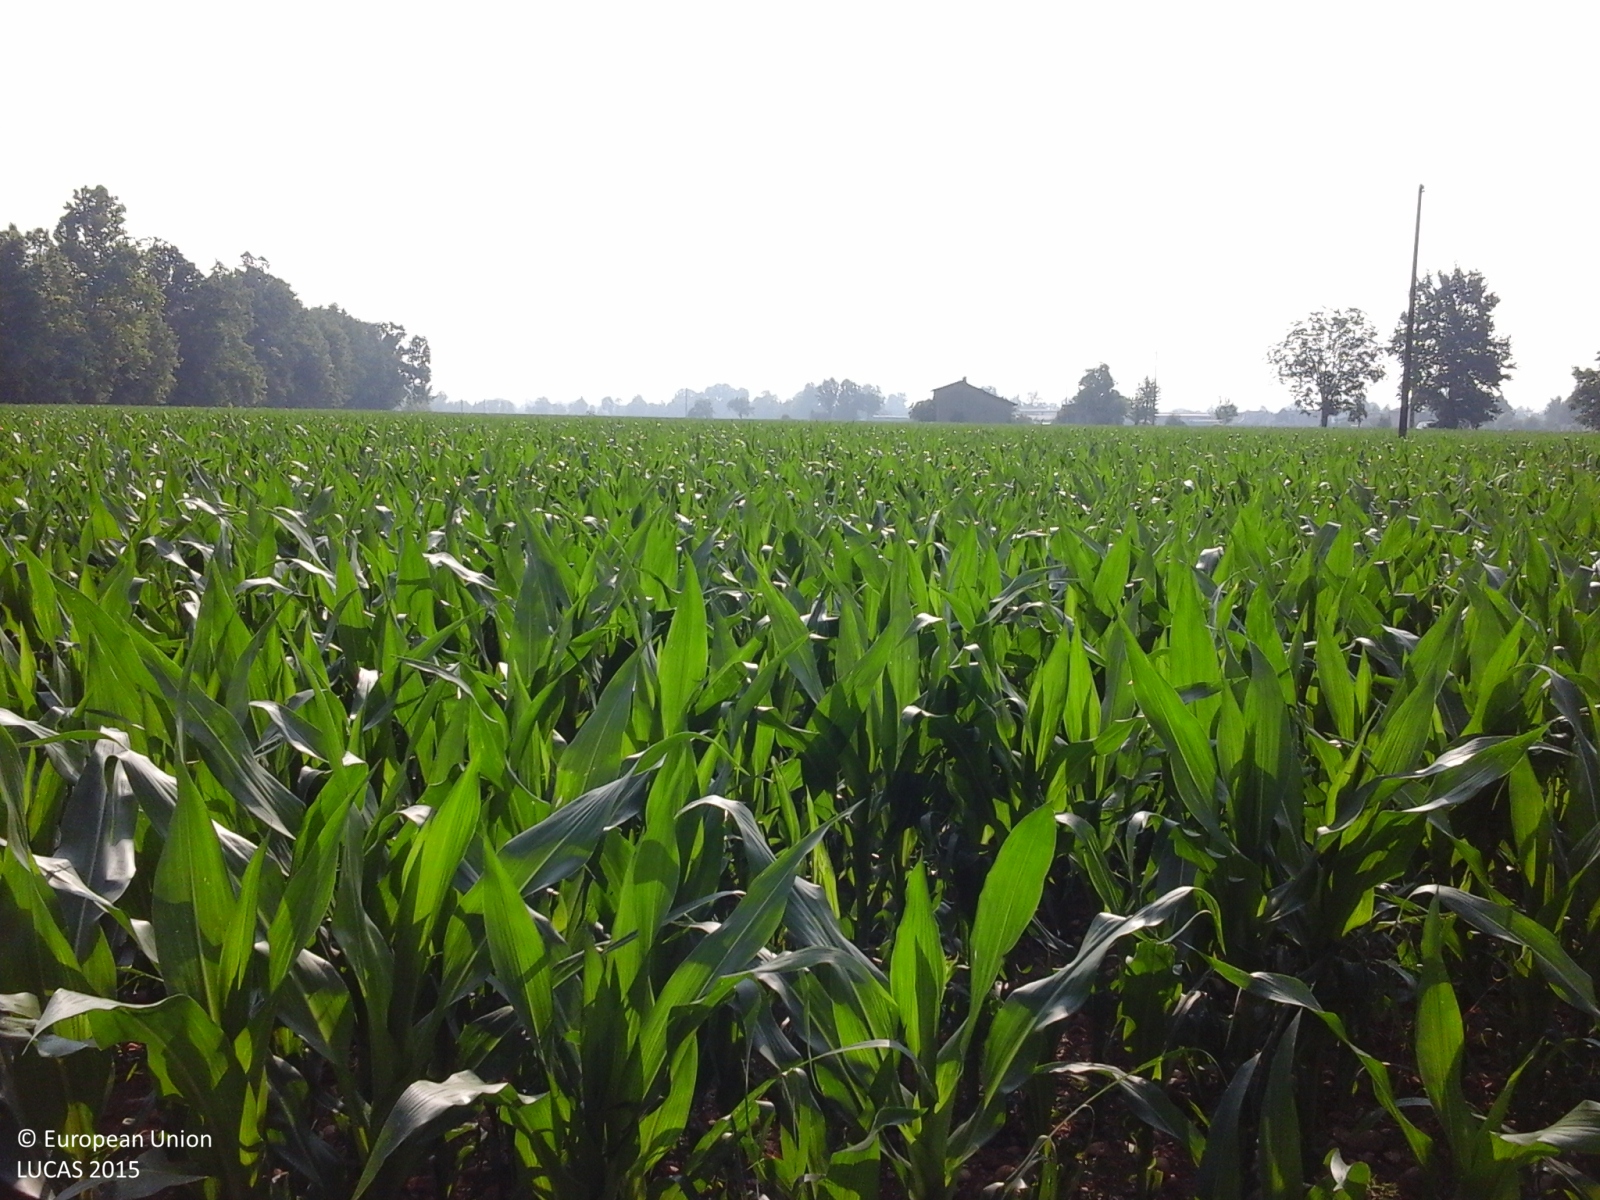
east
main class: Cropland
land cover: Common wheat
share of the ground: > 75 %
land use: Agriculture (excluding fallow land and kitchen gardens)
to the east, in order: Common wheat; Ditches and canals; Grass margins; Tracks; Maize; Electric lines; Maize; Ditches and canals; Grassland without tree/shrub cover; Maize
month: June
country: IT
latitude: 45.4683
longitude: 9.8595
